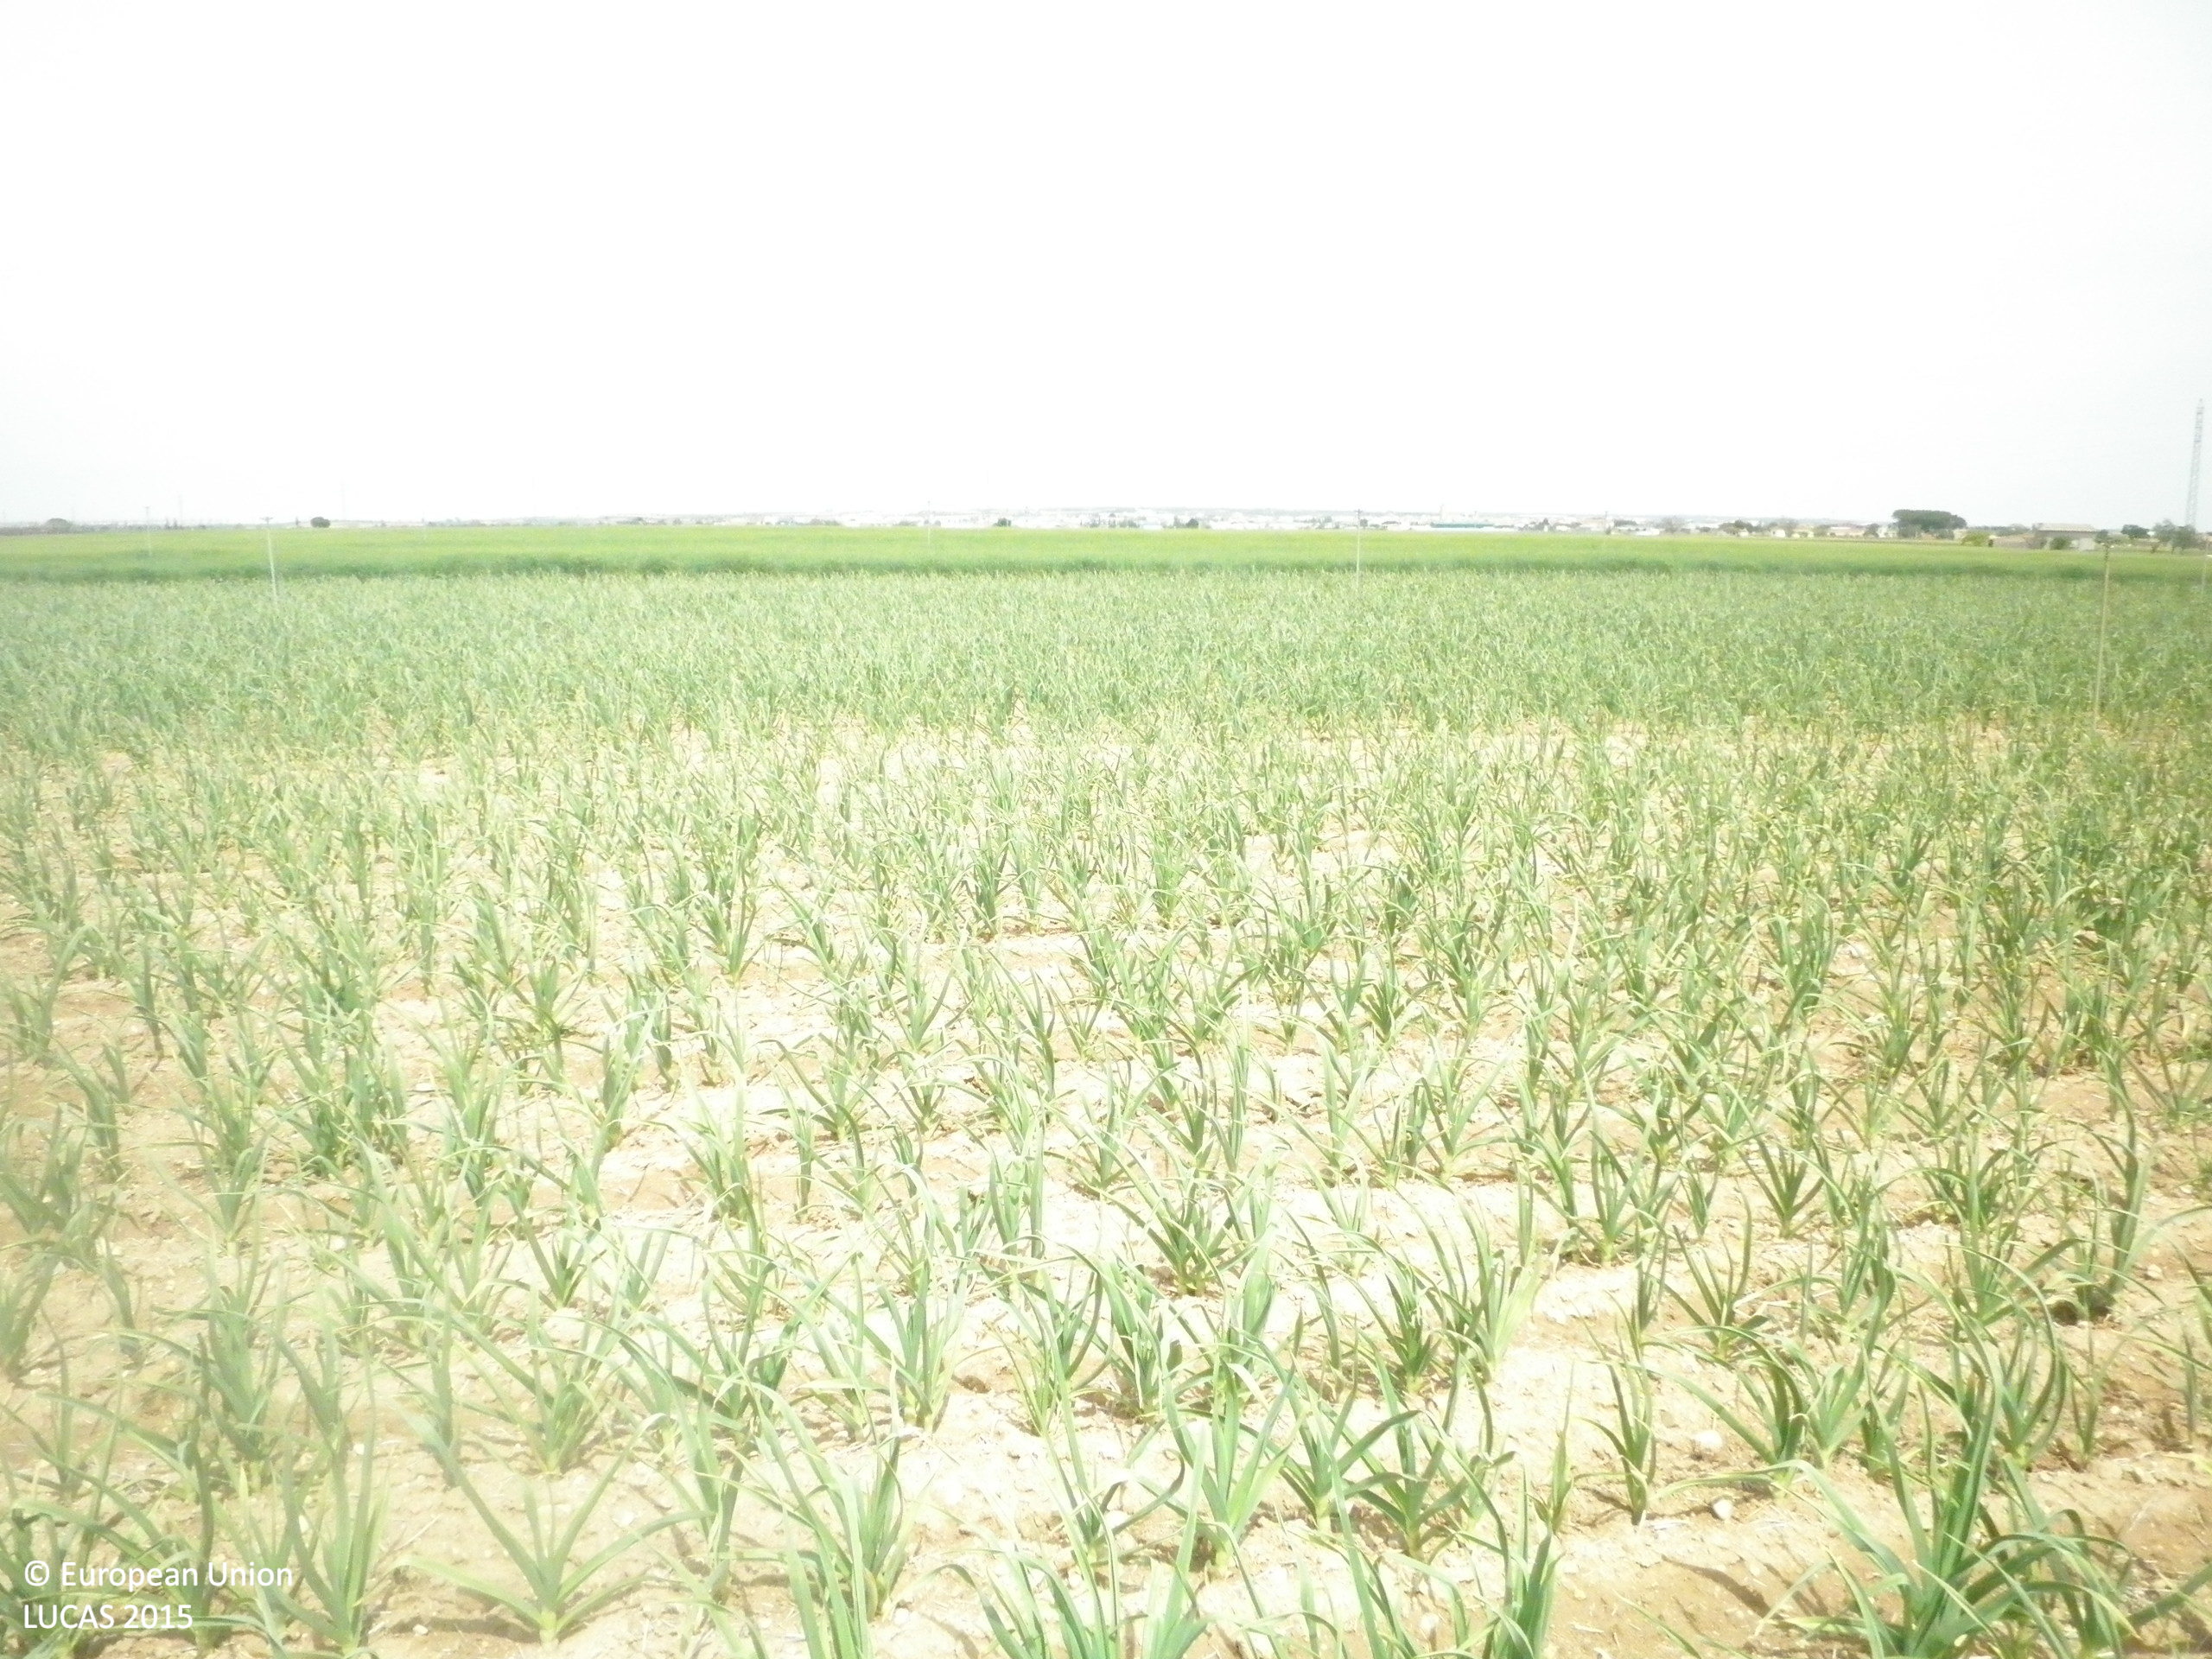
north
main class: Cropland
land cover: Other root crops
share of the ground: 10 - 25 %
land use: Agriculture (excluding fallow land and kitchen gardens)
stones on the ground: < 10 %
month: April
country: ES
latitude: 39.4219
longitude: -2.6859
